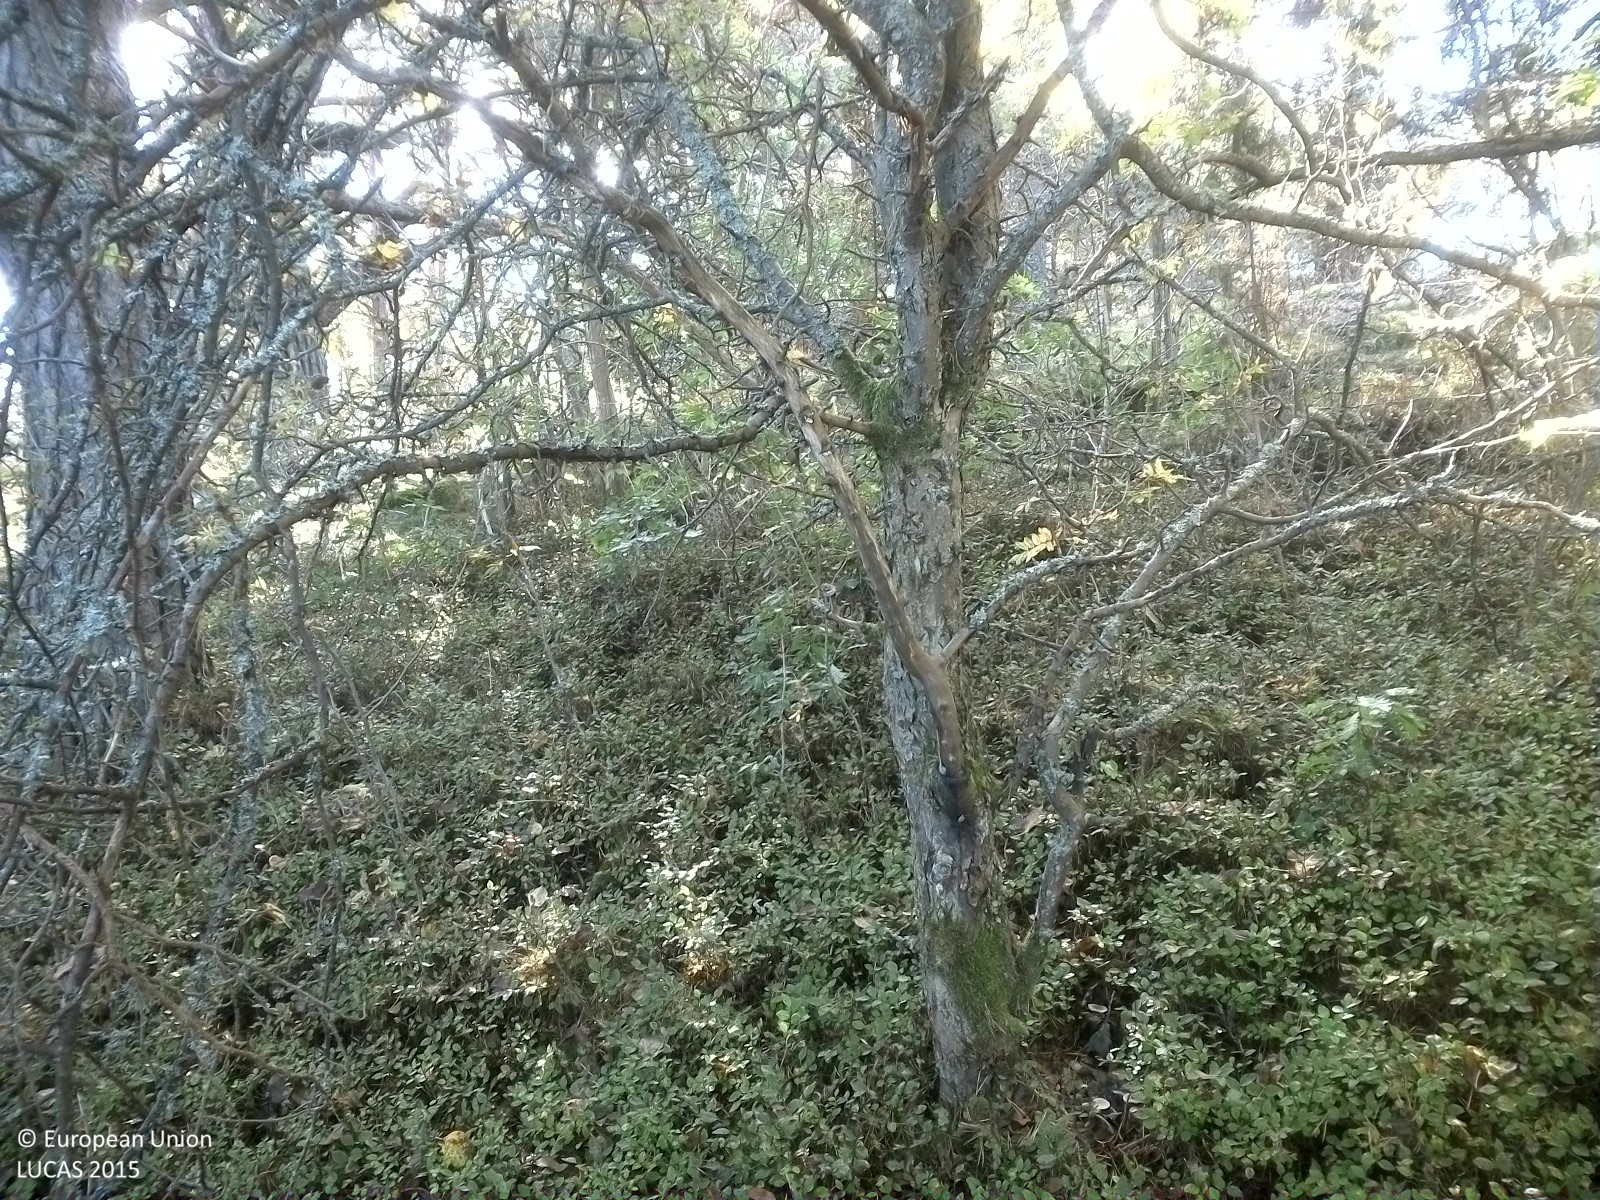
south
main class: Woodland
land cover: Pine dominated mixed woodland
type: boreal forest
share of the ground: 25 - 50 %
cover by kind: herbaceous plants 45 %, coniferous forest trees 25 %, broadleaved forest trees 20 %, shrubs 5 %, lichens and mosses 5 %
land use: Forestry
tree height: > 5 m
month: September
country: SE
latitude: 58.4932
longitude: 16.9112
